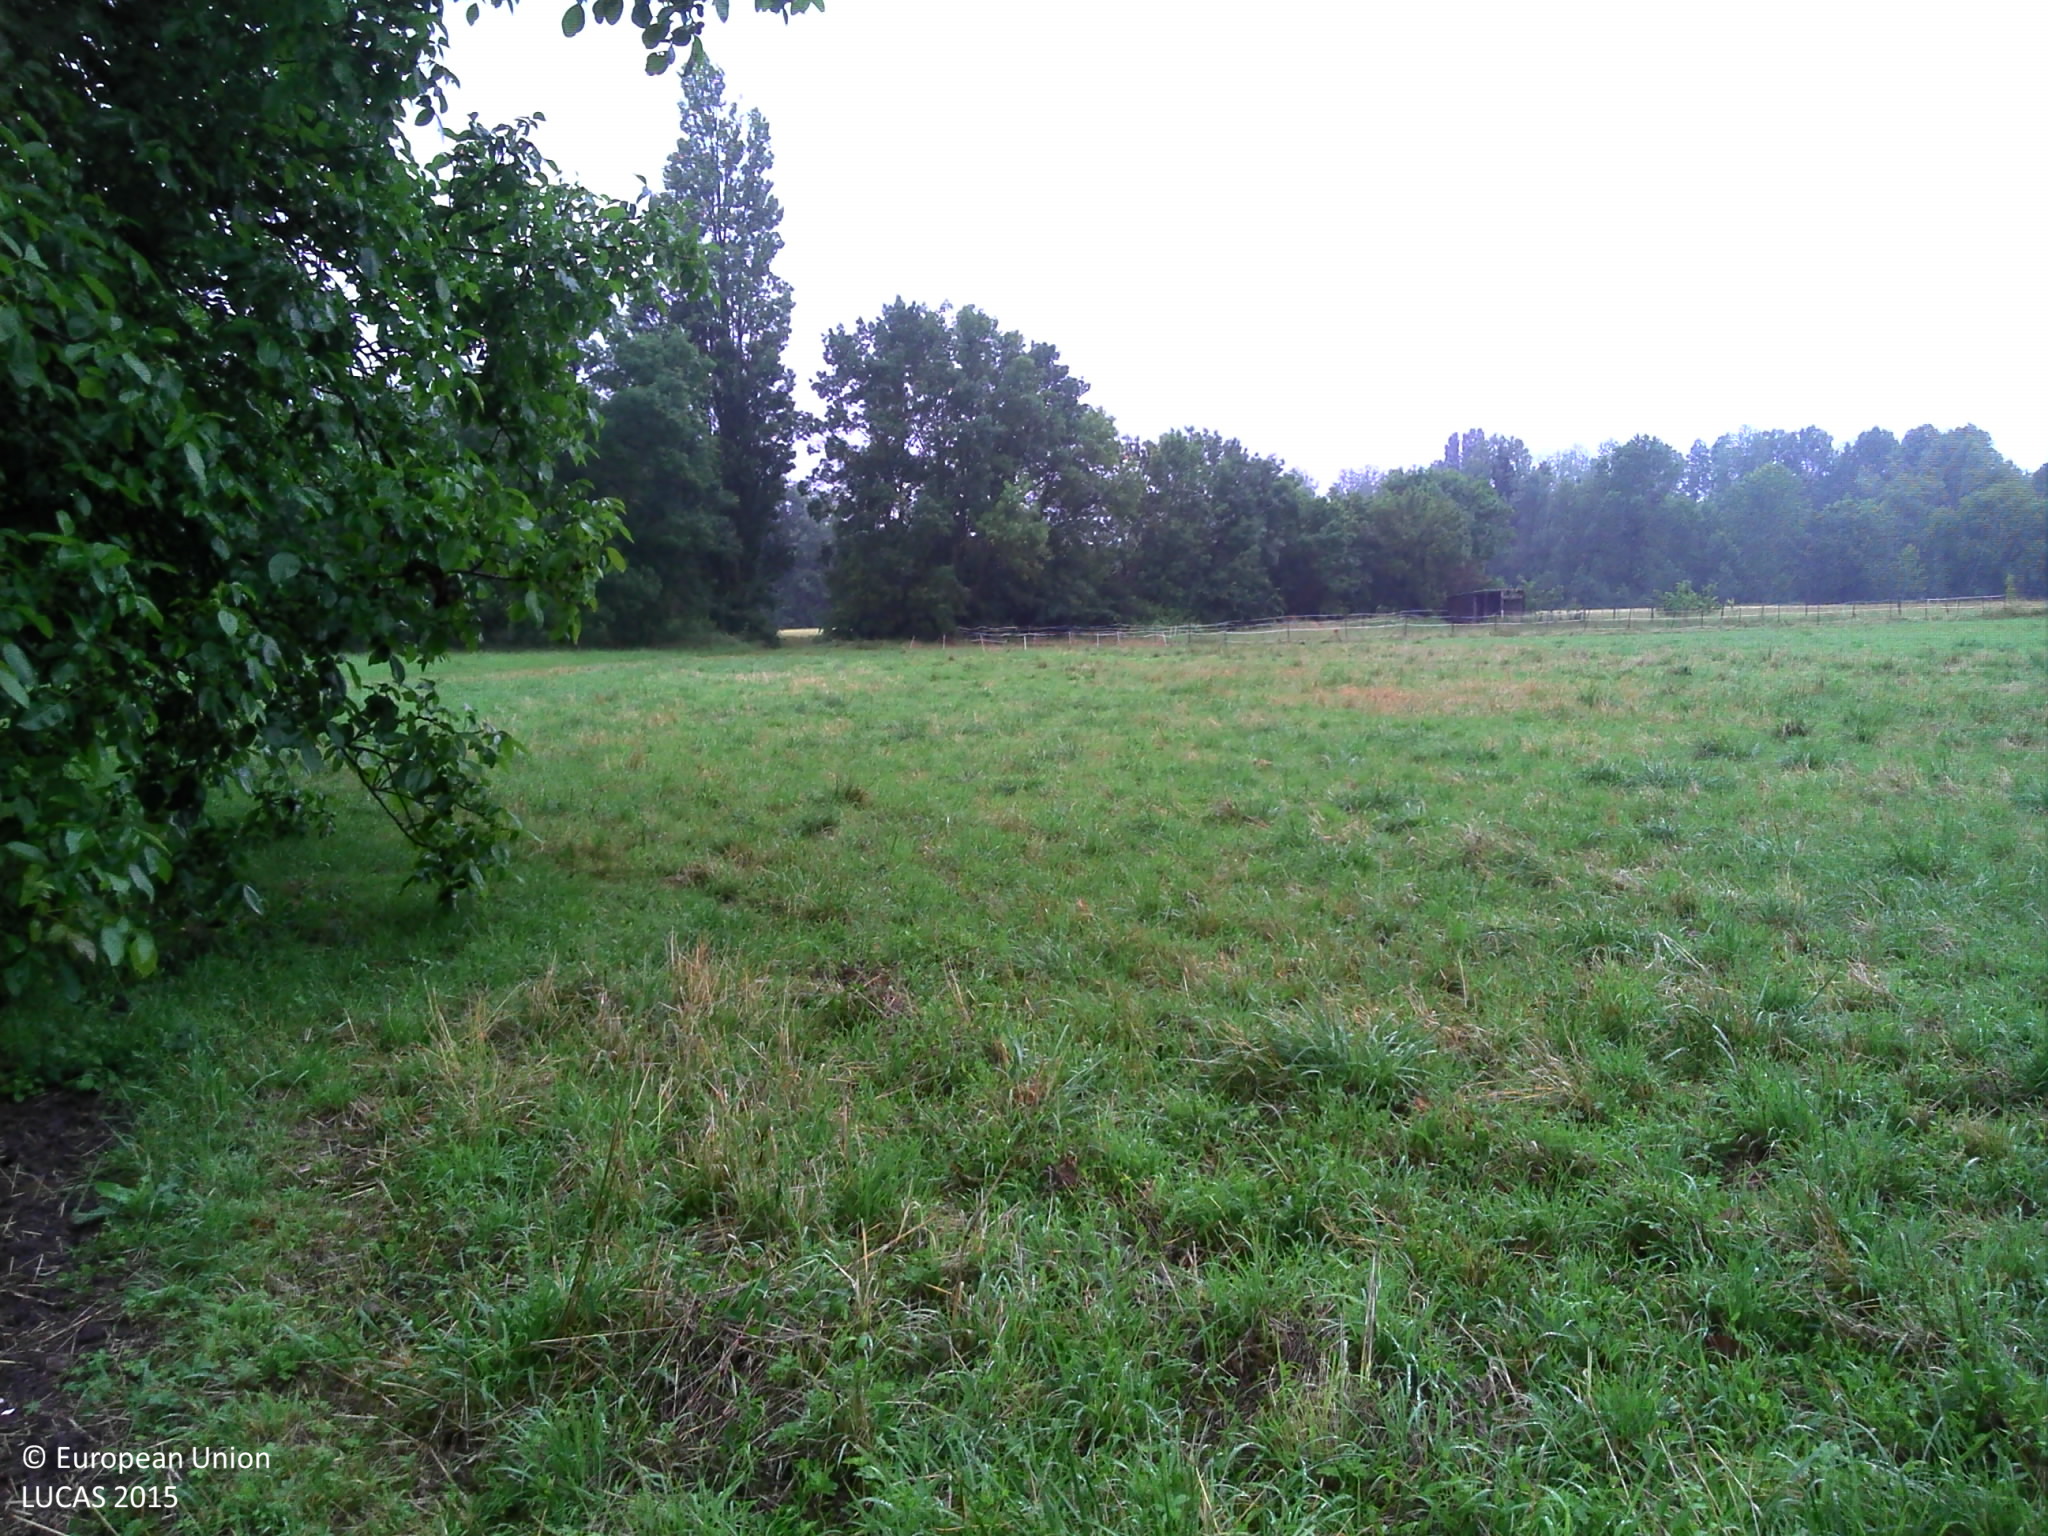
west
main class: Cropland
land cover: Other fresh vegetables
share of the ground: < 10 %
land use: Kitchen garden
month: June
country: FR
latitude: 46.7201
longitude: 0.4436
